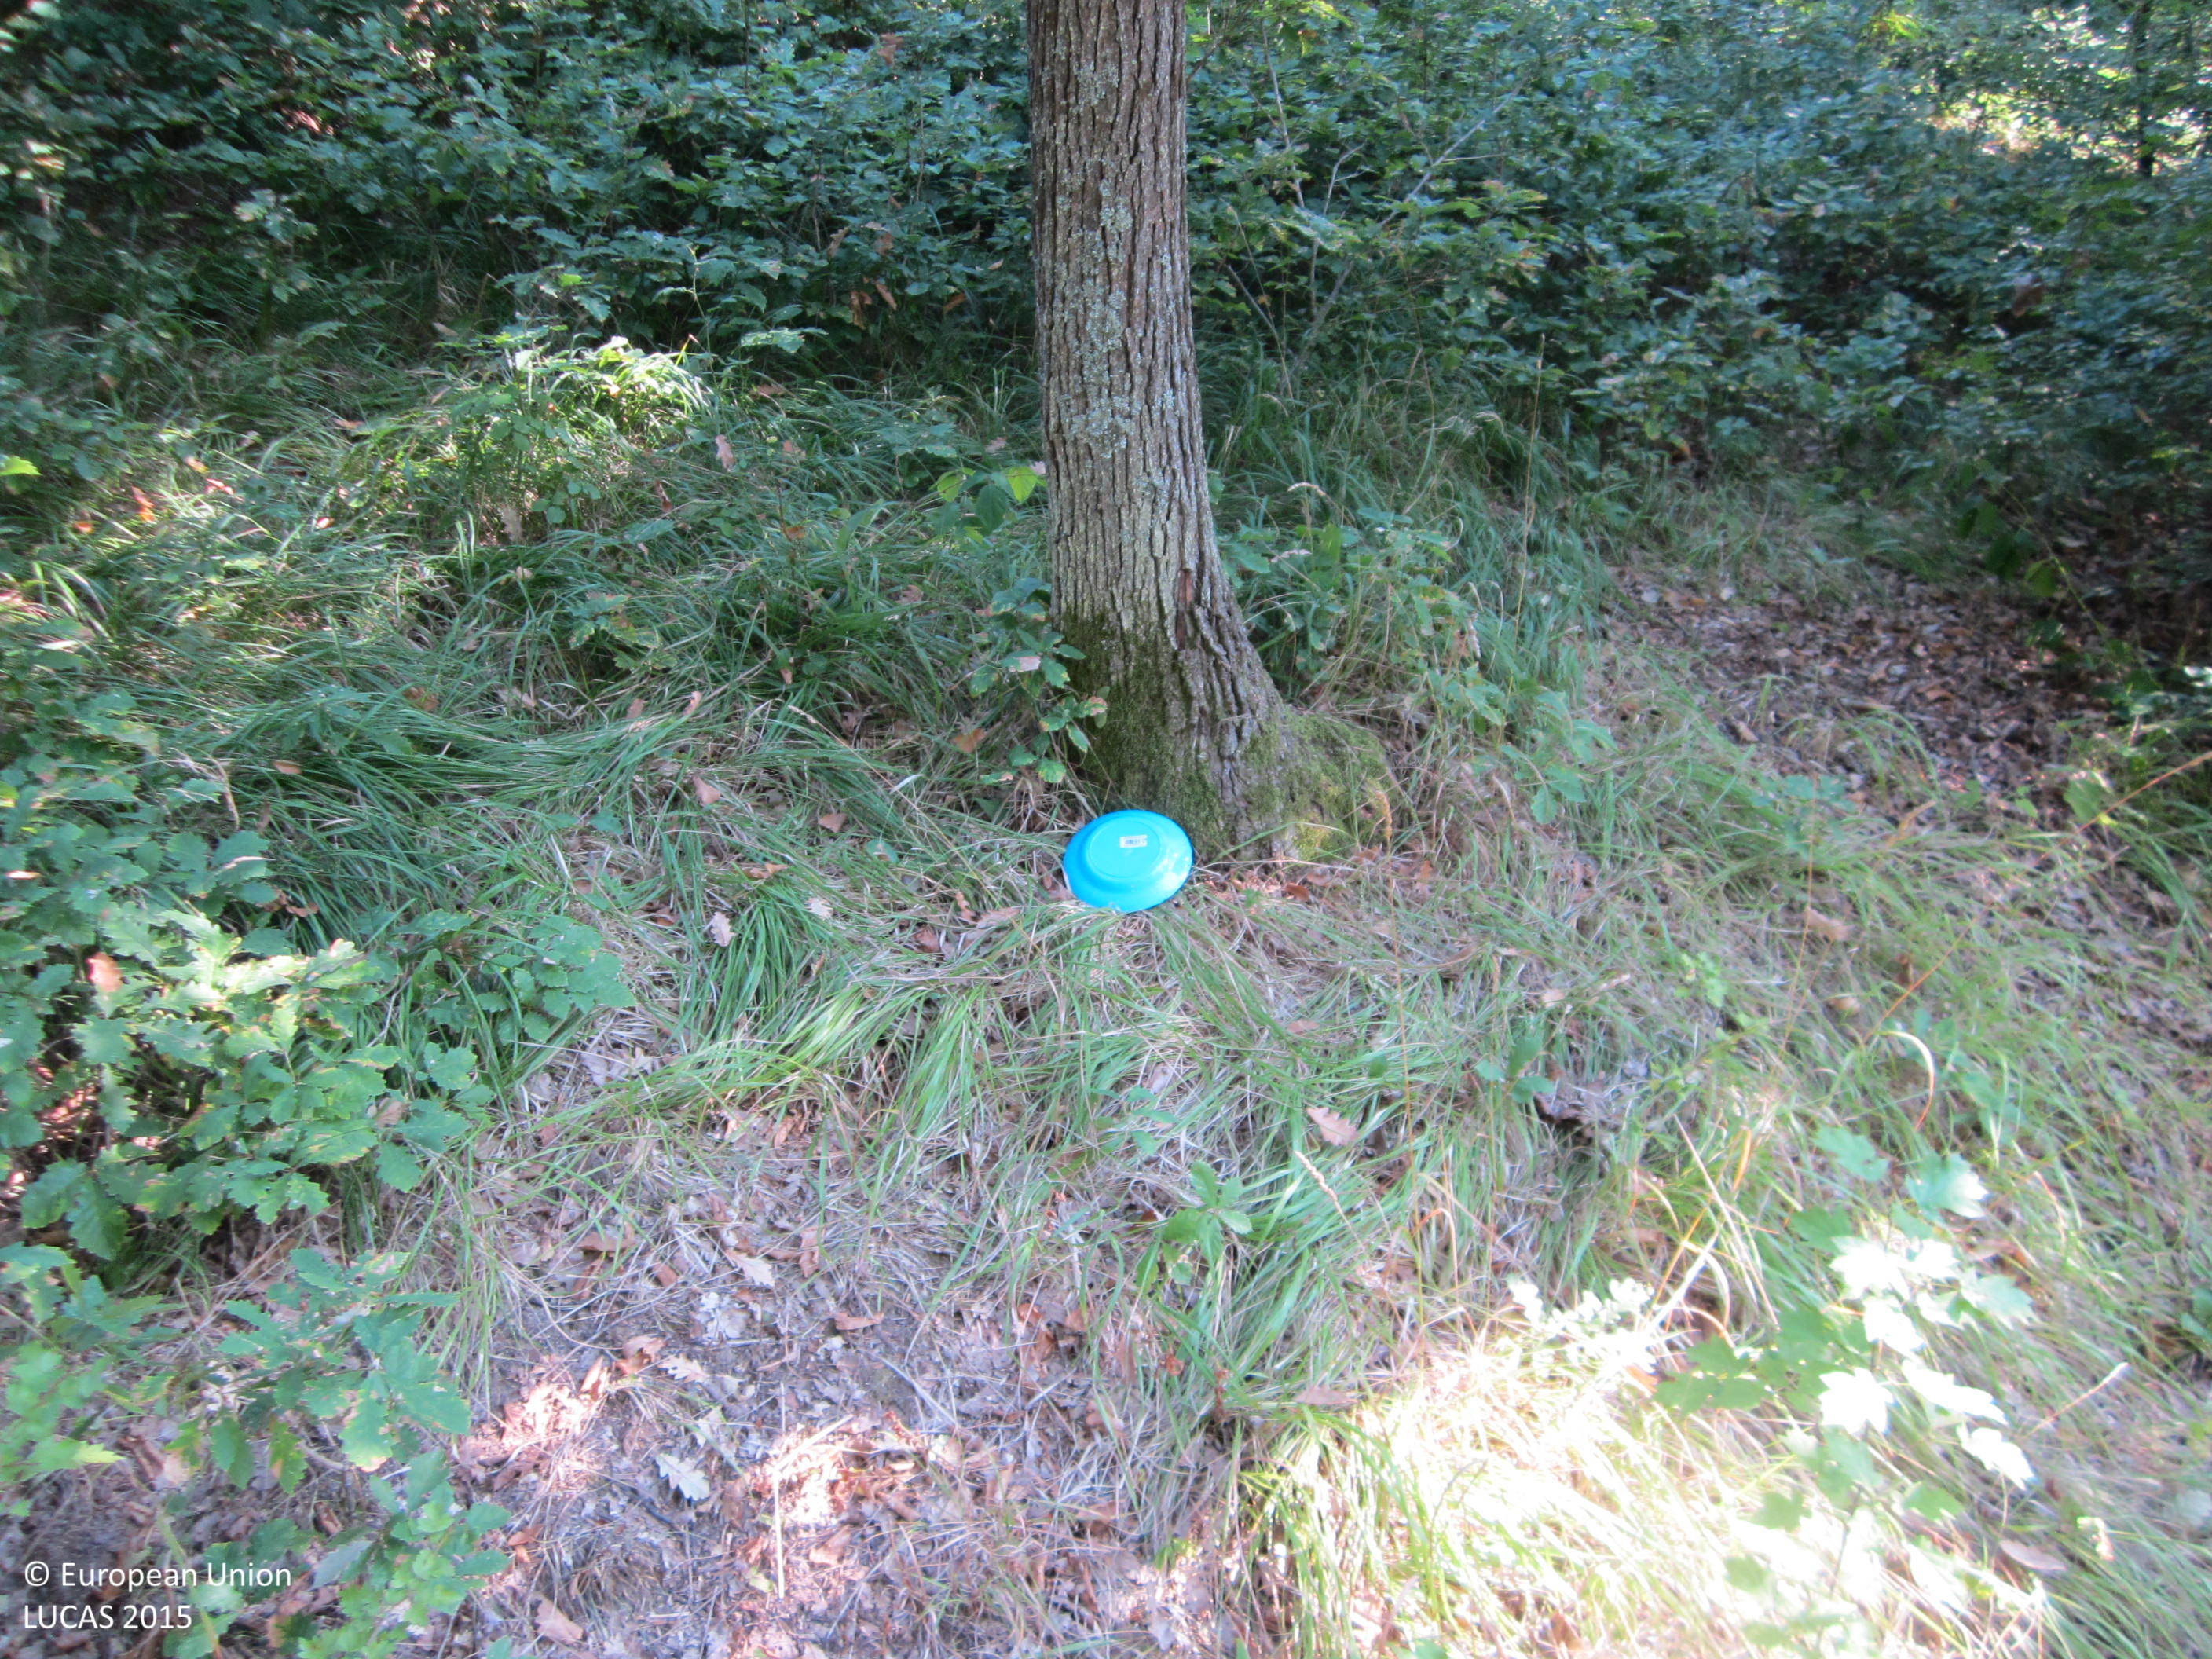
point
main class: Woodland
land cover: Broadleaved woodland
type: mesophytic deciduous forest
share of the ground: > 75 %
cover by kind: broadleaved forest trees 85 %, herbaceous plants 10 %, shrubs 5 %
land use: Forestry
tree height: > 5 m
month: September
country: BG
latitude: 42.8630
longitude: 27.3143
